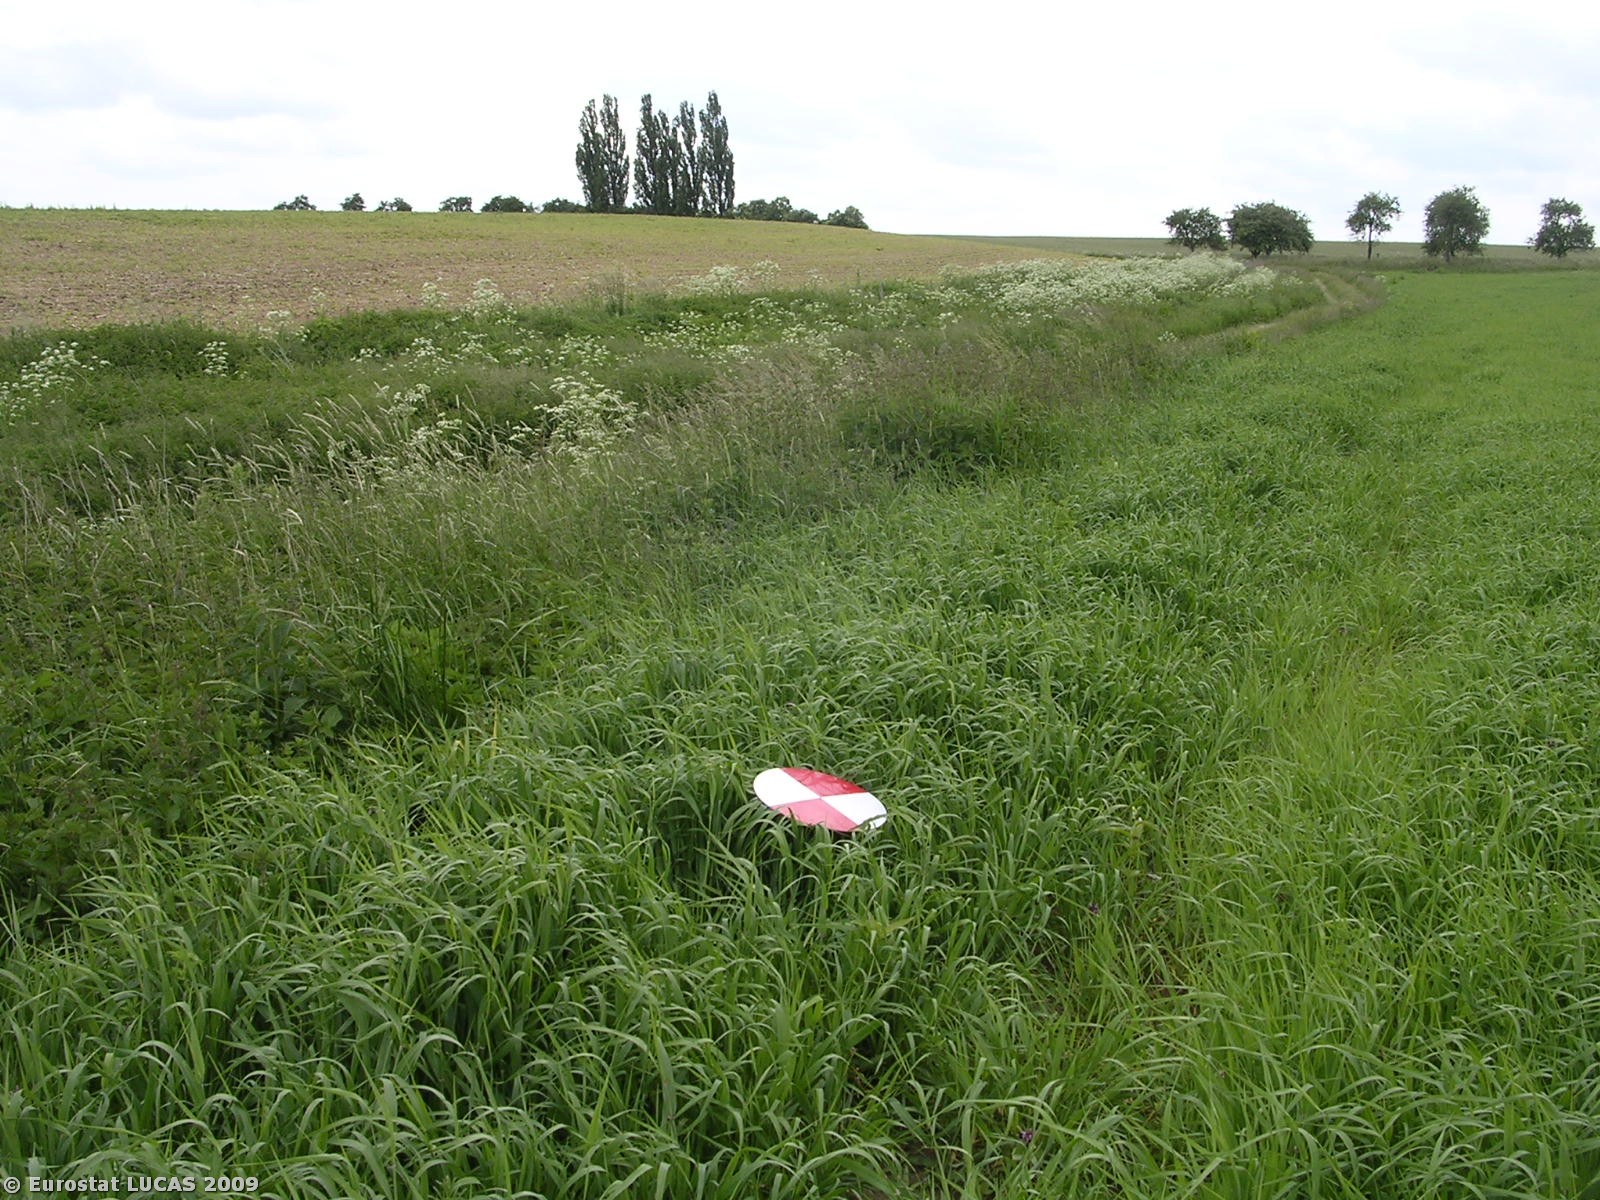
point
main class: Cropland
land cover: Barley
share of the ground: > 75 %
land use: Agriculture (excluding fallow land and kitchen gardens)
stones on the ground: < 10 %
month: June
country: CZ
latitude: 50.4827
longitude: 14.7234
